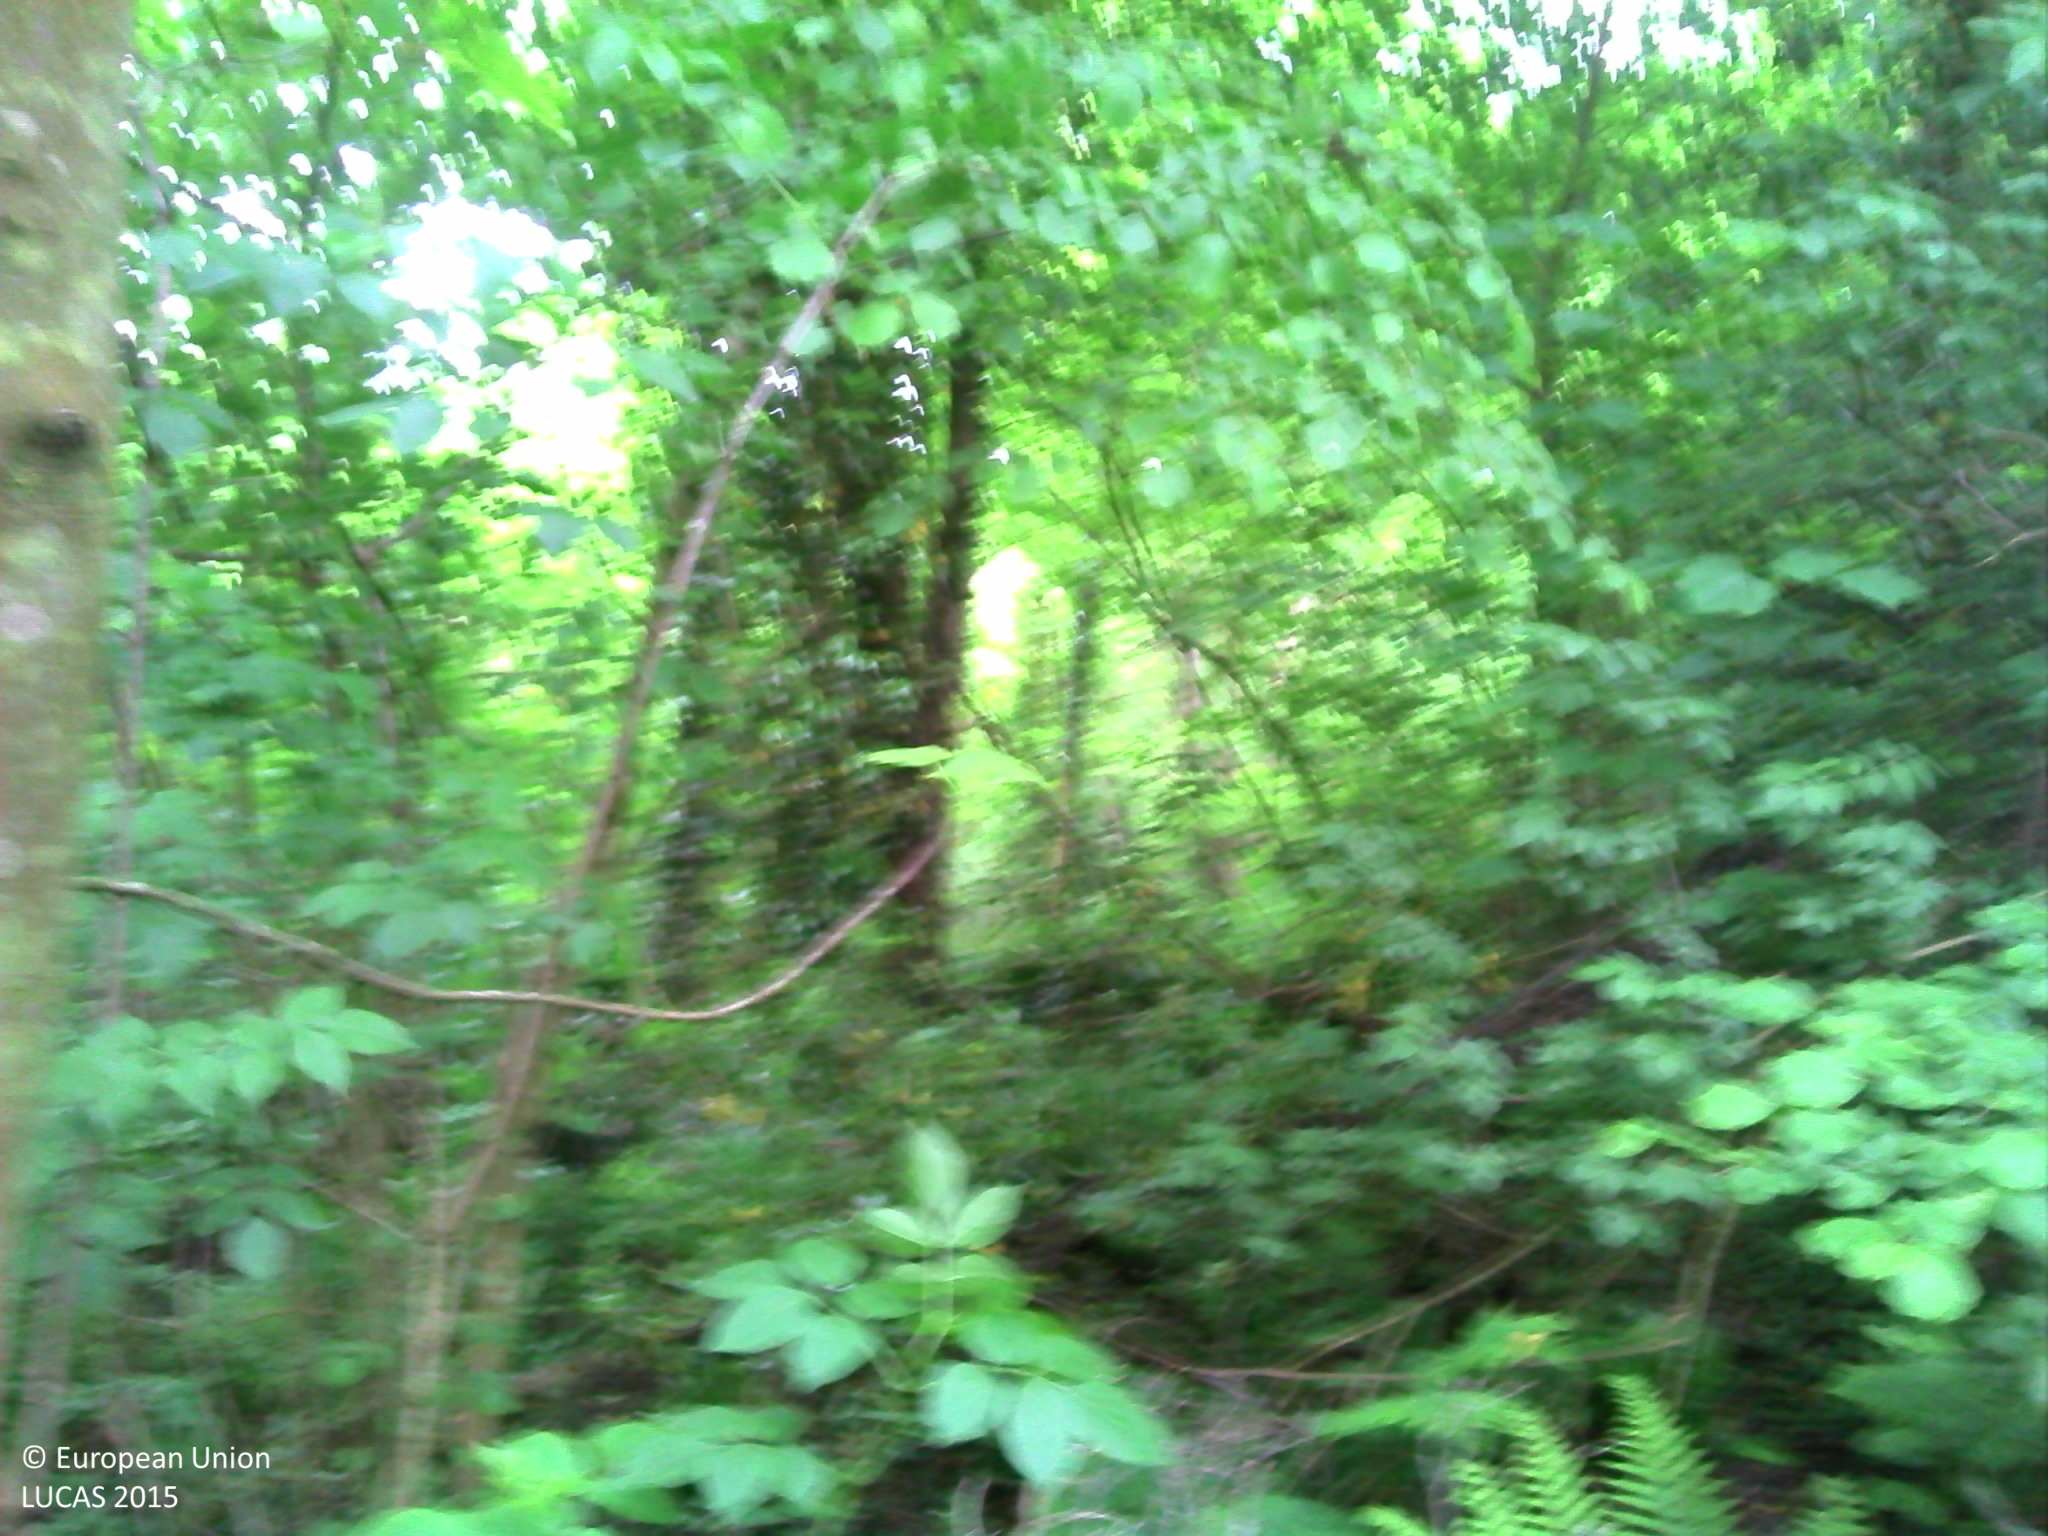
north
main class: Woodland
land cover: Broadleaved woodland
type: mesophytic deciduous forest
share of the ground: > 75 %
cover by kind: broadleaved forest trees 80 %, shrubs 15 %, herbaceous plants 5 %
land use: Semi-natural and natural areas not in use
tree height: > 5 m
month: May
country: FR
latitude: 49.2856
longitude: -0.0539
